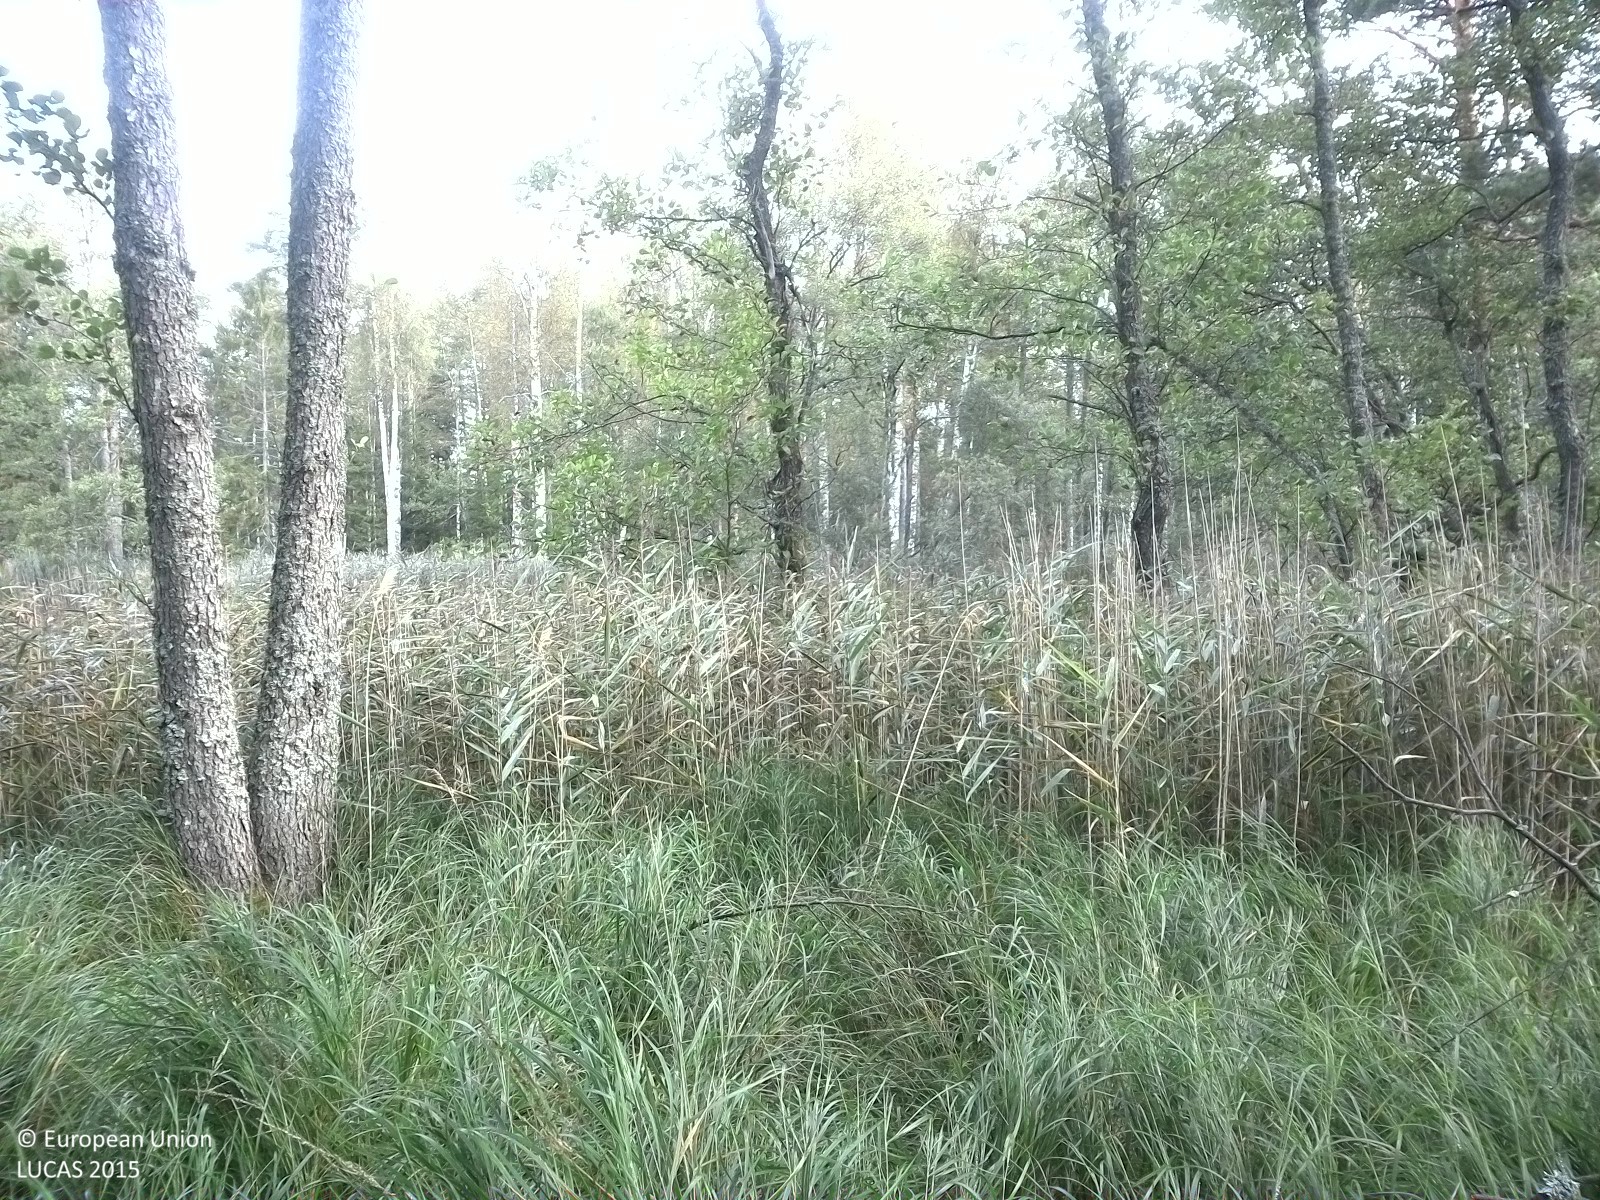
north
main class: Woodland
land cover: Pine dominated mixed woodland
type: boreal forest
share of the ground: 10 - 25 %
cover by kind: herbaceous plants 80 %, coniferous forest trees 15 %, broadleaved forest trees 5 %
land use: Semi-natural and natural areas not in use
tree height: > 5 m
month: August
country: SE
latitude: 58.8484
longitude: 15.4524
